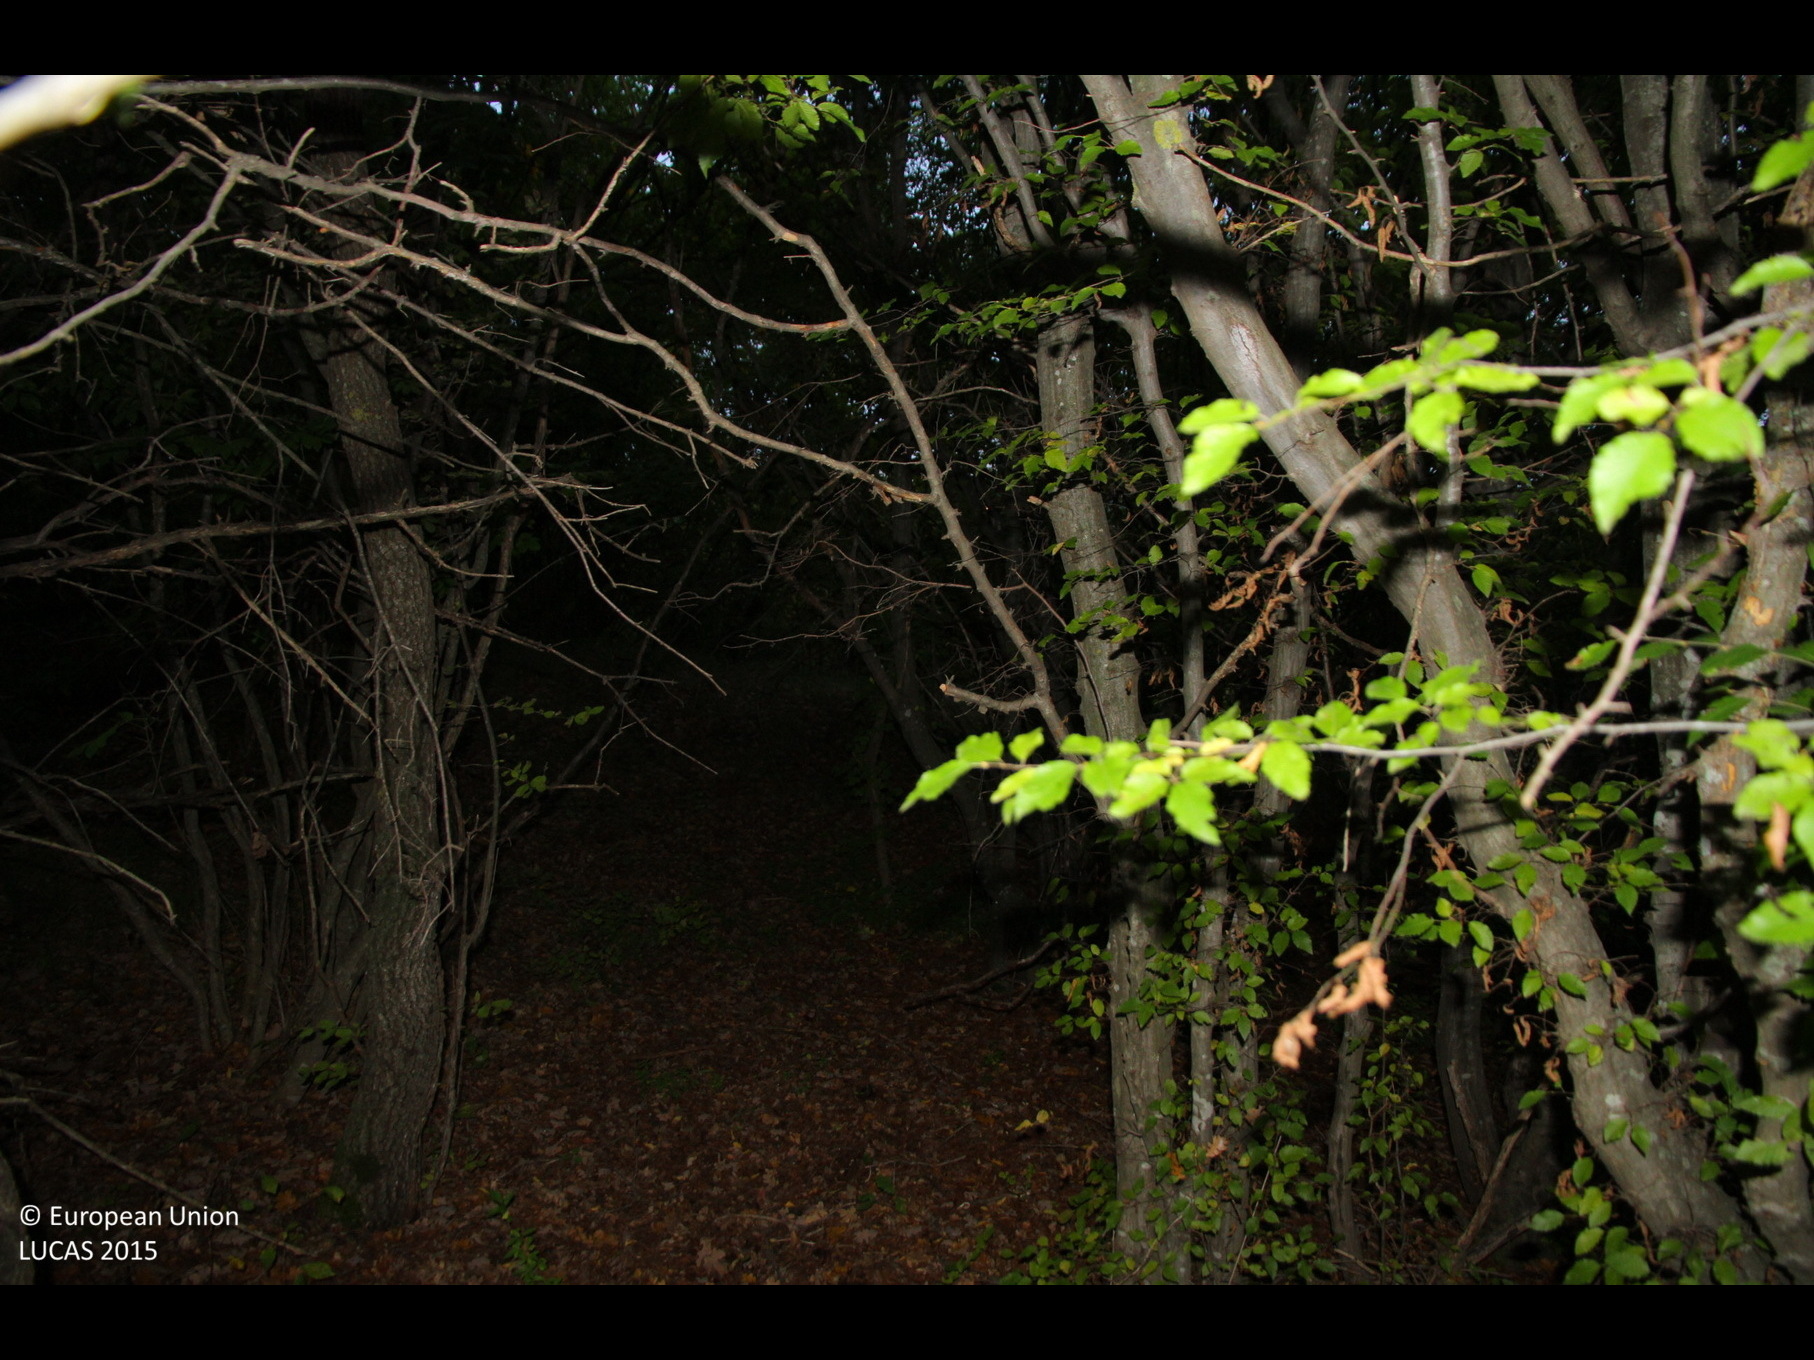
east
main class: Woodland
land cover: Broadleaved woodland
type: beech forest
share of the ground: > 75 %
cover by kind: broadleaved forest trees 100 %
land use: Forestry
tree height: < 5 m
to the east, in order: Broadleaved woodland; Tracks; Broadleaved woodland; Shrubland without tree cover; Tracks; Shrubland without tree cover; Arable land (only in case pi)
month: October
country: BG
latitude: 43.2318
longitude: 27.0964
